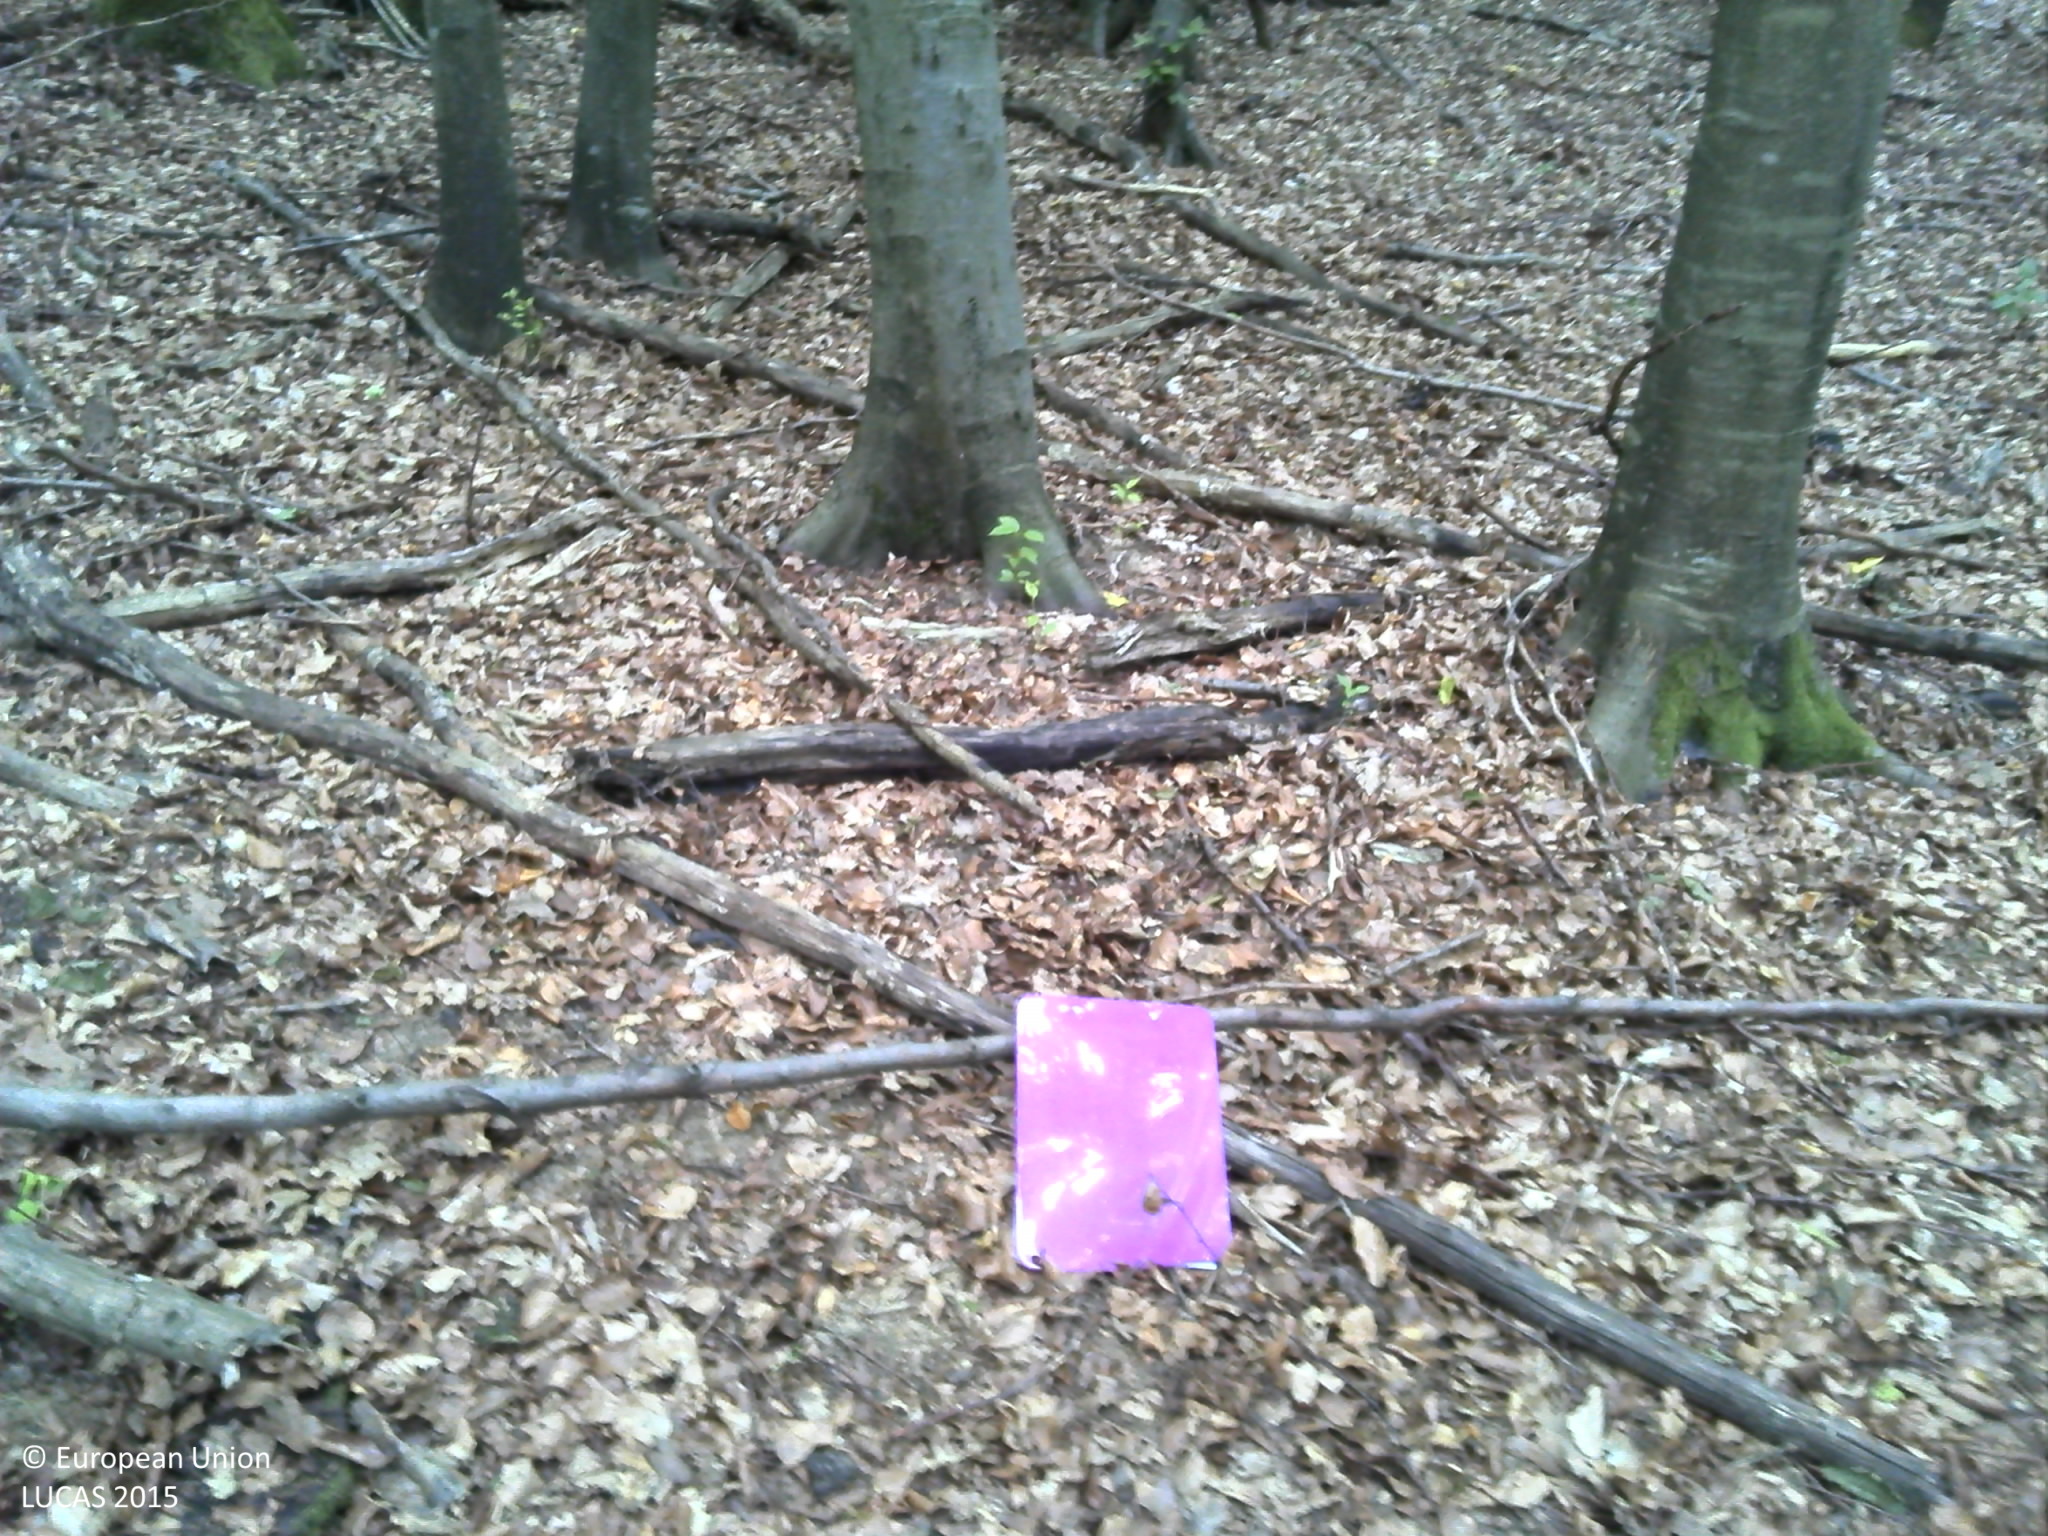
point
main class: Woodland
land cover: Broadleaved woodland
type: beech forest
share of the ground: > 75 %
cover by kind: broadleaved forest trees 80 %, lichens and mosses 20 %
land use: Forestry
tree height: > 5 m
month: June
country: HR
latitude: 45.4738
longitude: 17.4845
